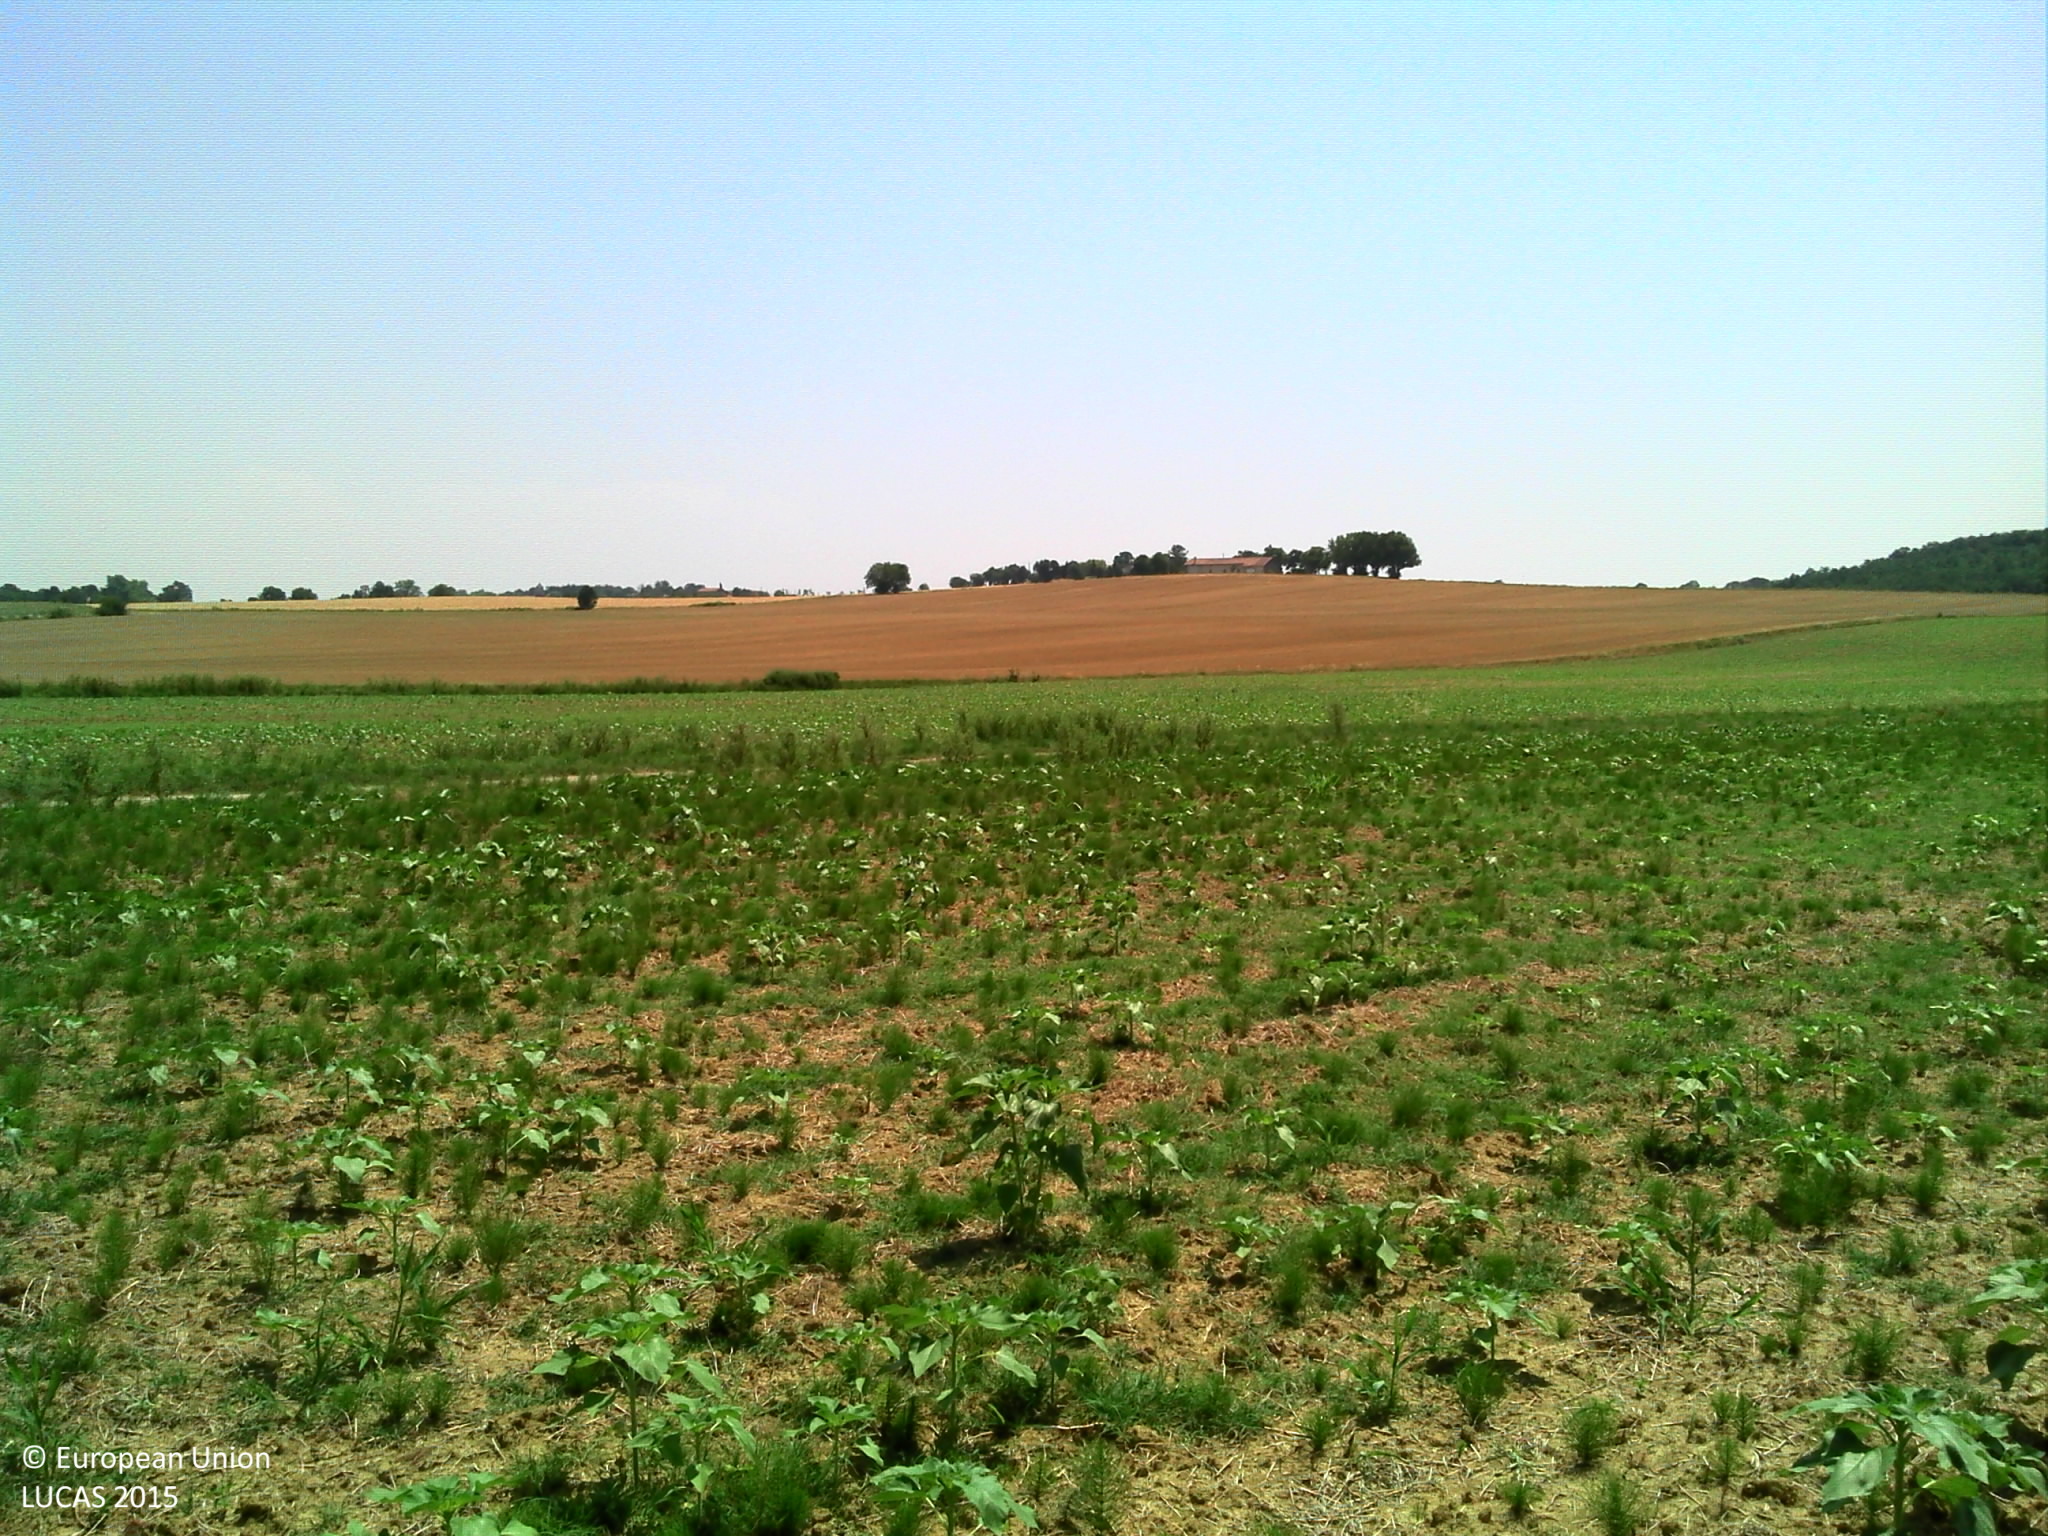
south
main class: Cropland
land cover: Sunflower
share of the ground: > 75 %
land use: Agriculture (excluding fallow land and kitchen gardens)
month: July
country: FR
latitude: 43.6040
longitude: 1.7406
